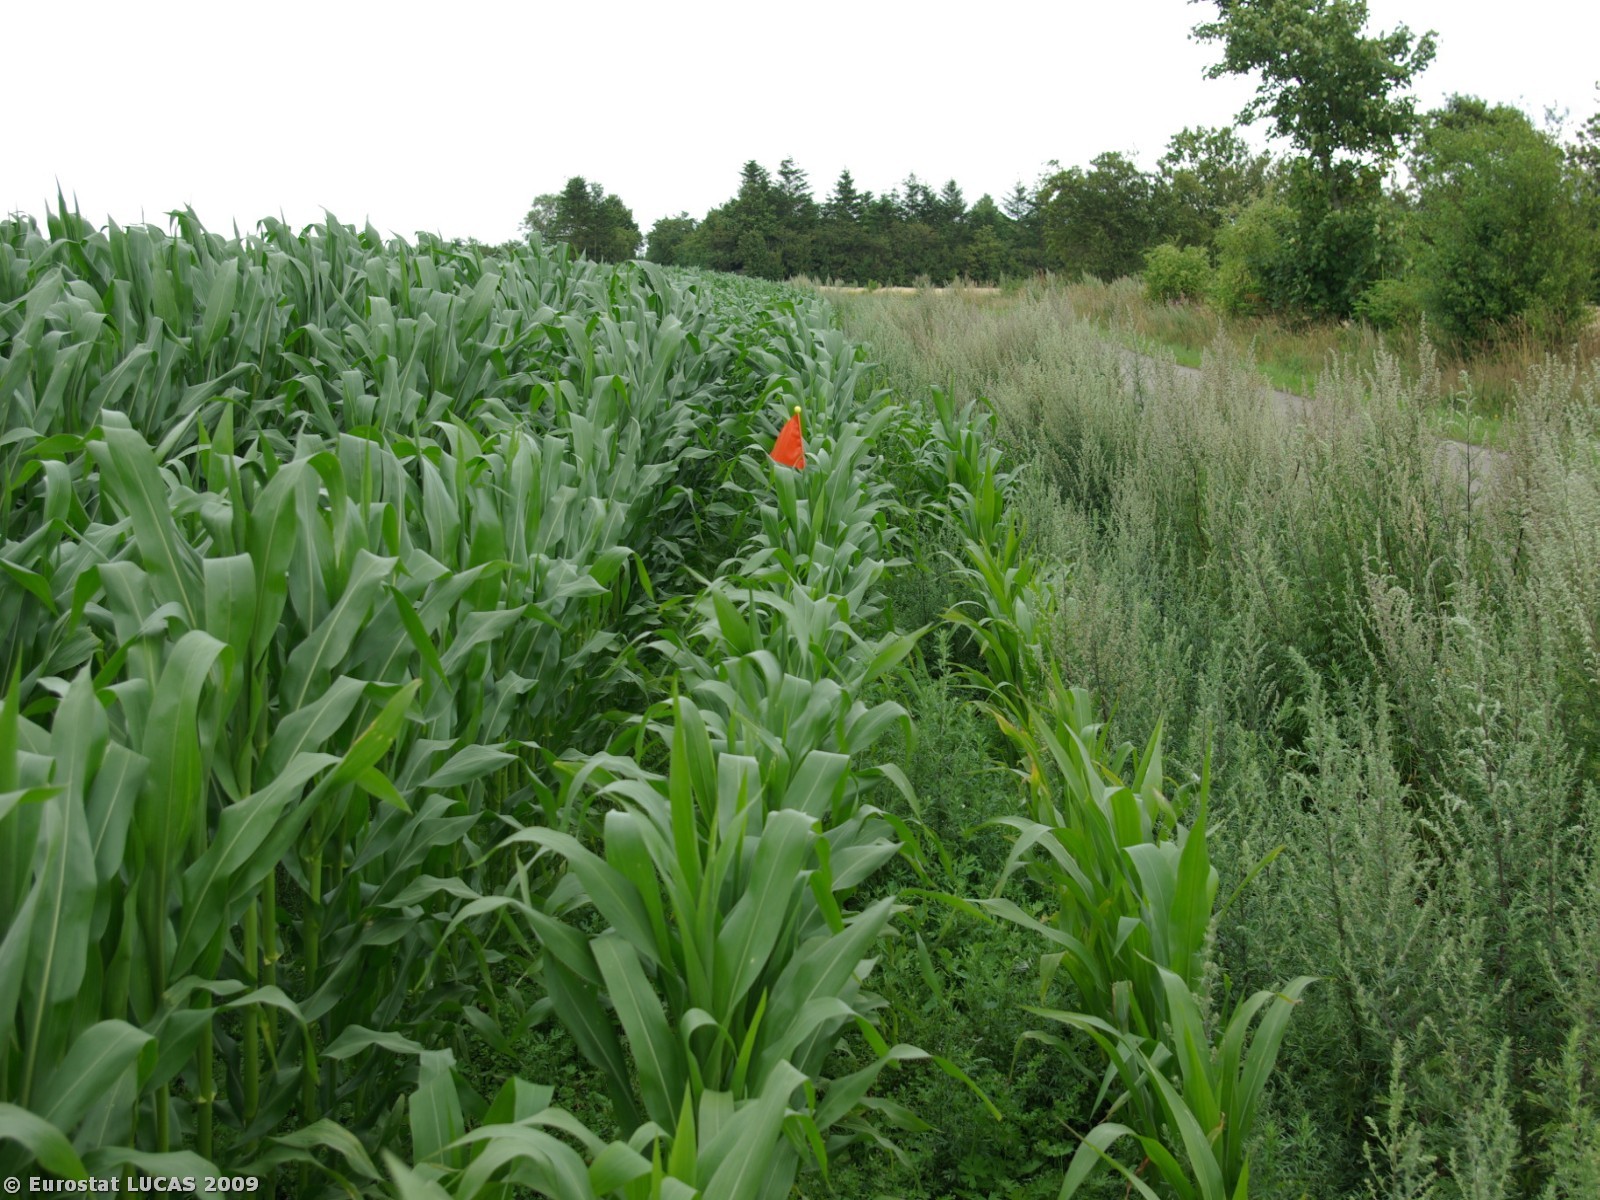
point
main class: Cropland
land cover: Maize
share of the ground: > 75 %
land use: Agriculture (excluding fallow land and kitchen gardens)
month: July
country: DK
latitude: 55.2125
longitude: 8.9165
